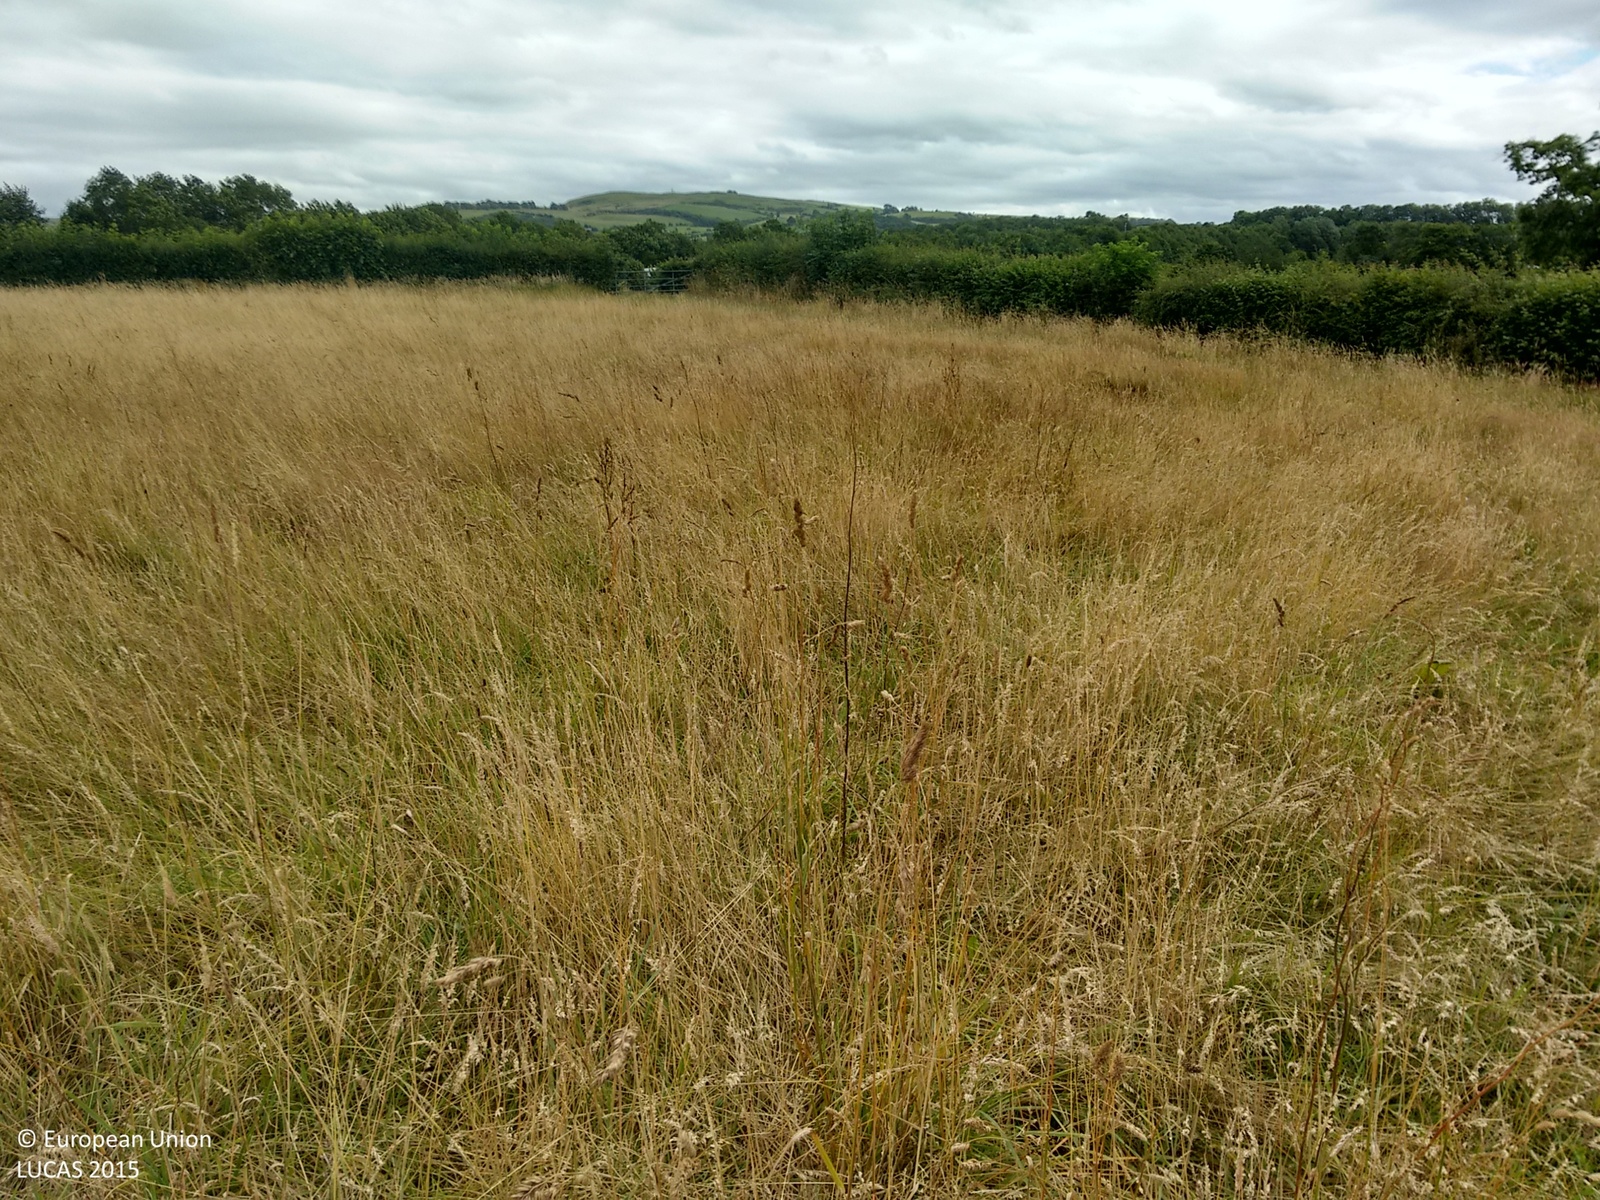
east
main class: Grassland
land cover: Grassland without tree/shrub cover
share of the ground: > 75 %
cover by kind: herbaceous plants 100 %
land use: Agriculture (excluding fallow land and kitchen gardens)
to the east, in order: Grassland without tree/shrub cover; Fences; Grass margins; Paved roads, cycling and walking lanes; Grass margins; Managed hedges; Grassland without tree/shrub cover; Fences; Paved roads, cycling and walking lanes; Fences; Broadleaved woodland
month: August
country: GB
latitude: 54.2388
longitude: -2.7267
